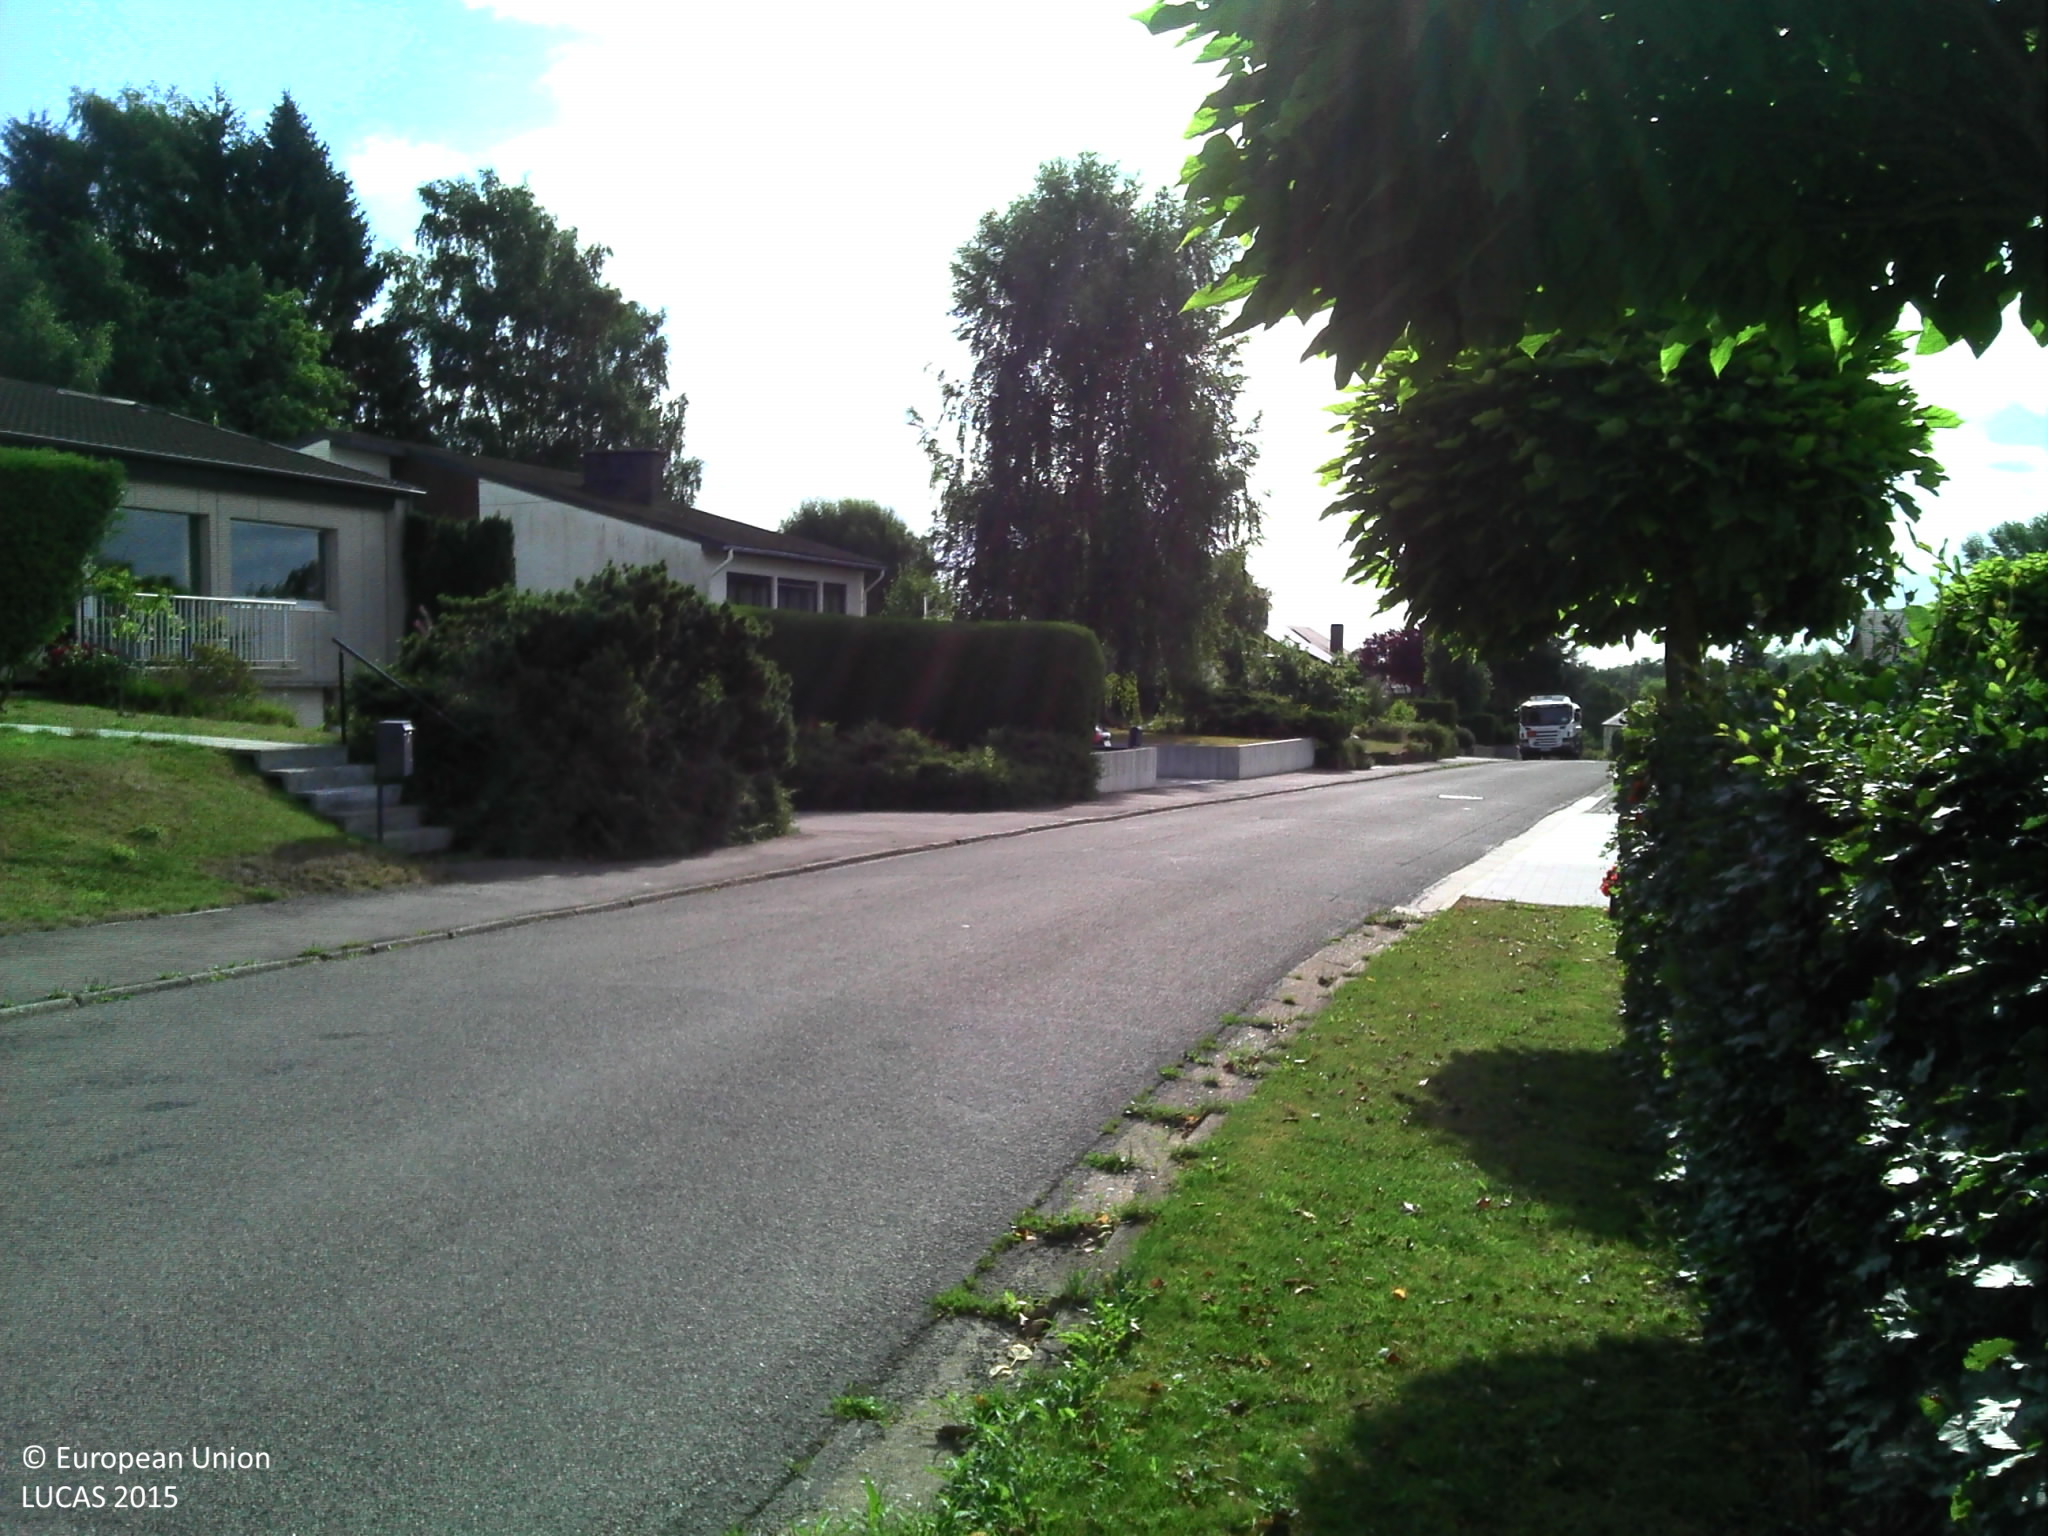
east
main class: Grassland
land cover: Grassland without tree/shrub cover
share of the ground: > 75 %
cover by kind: herbaceous plants 100 %
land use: Residential
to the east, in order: Grassland without tree/shrub cover; Artificial constructions in urban areas
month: July
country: BE
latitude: 49.6758
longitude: 5.8278
